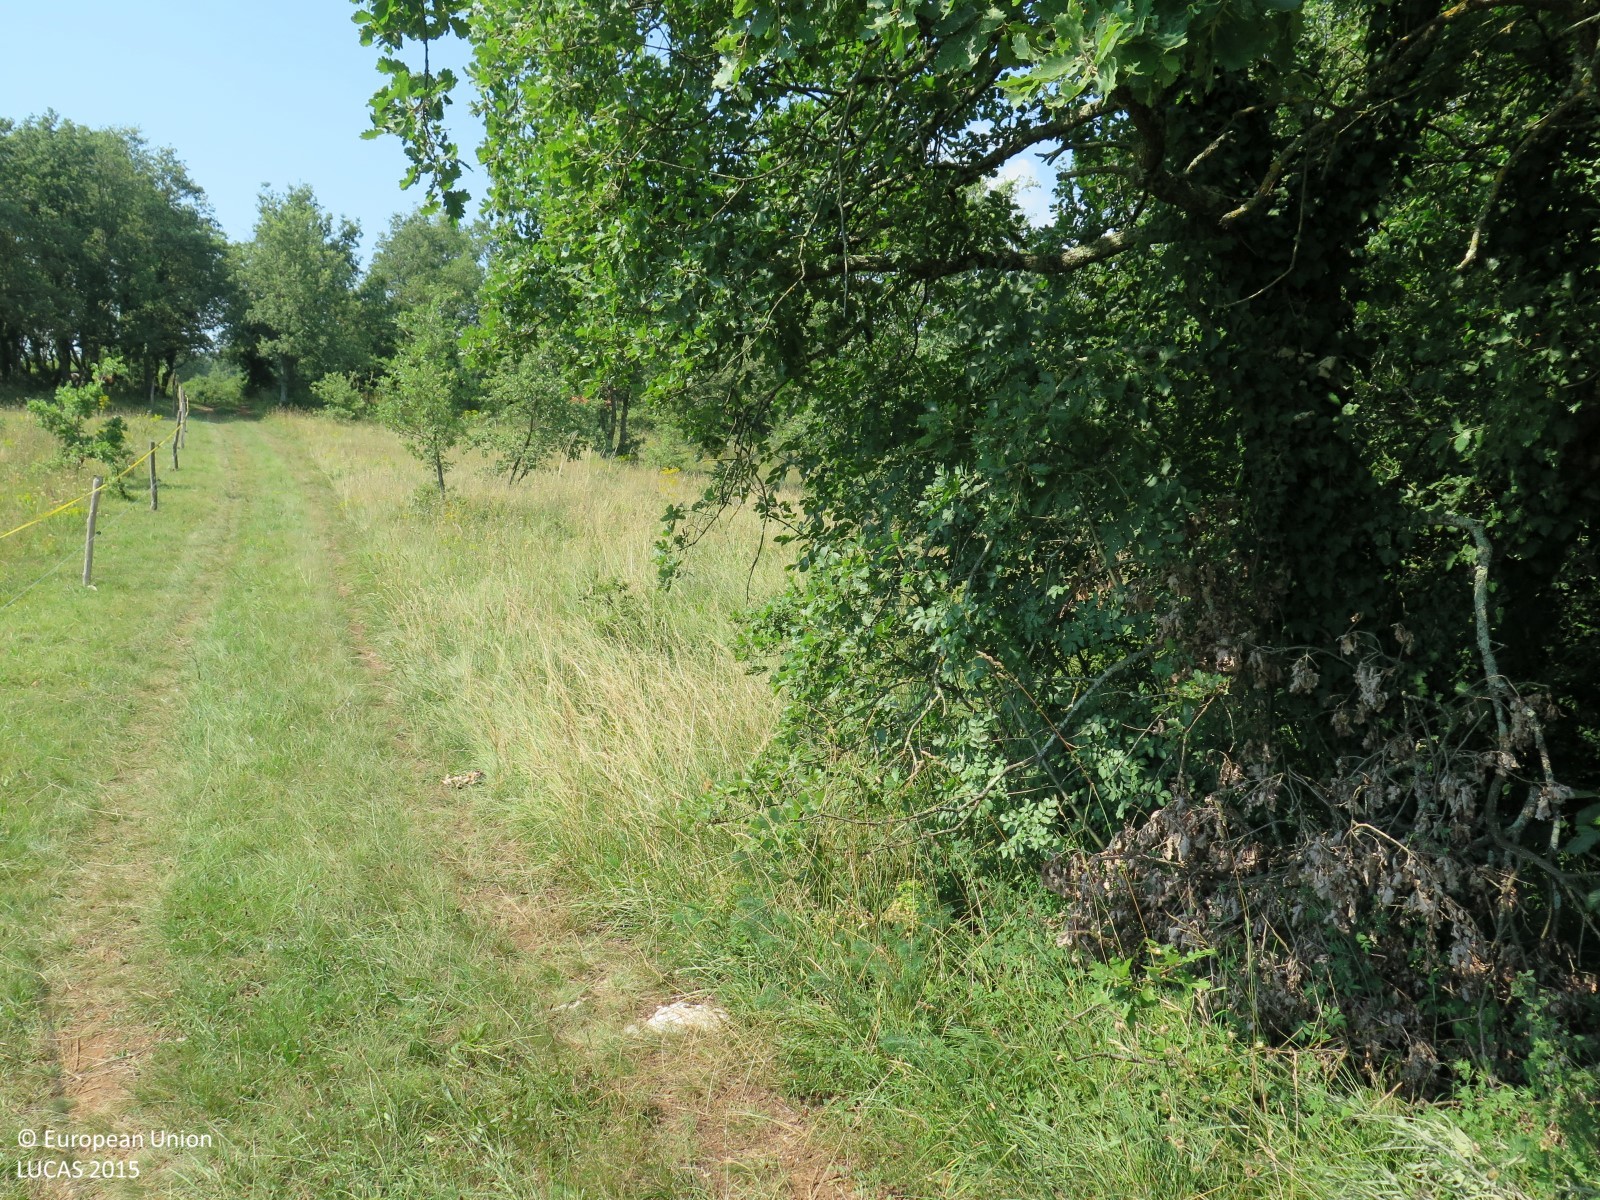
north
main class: Grassland
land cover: Grassland with sparse tree/shrub cover
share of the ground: > 75 %
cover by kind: herbaceous plants 90 %, broadleaved forest trees 5 %, shrubs 5 %
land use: Agriculture (excluding fallow land and kitchen gardens)
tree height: < 5 m
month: July
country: HR
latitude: 45.2185
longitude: 13.8278
